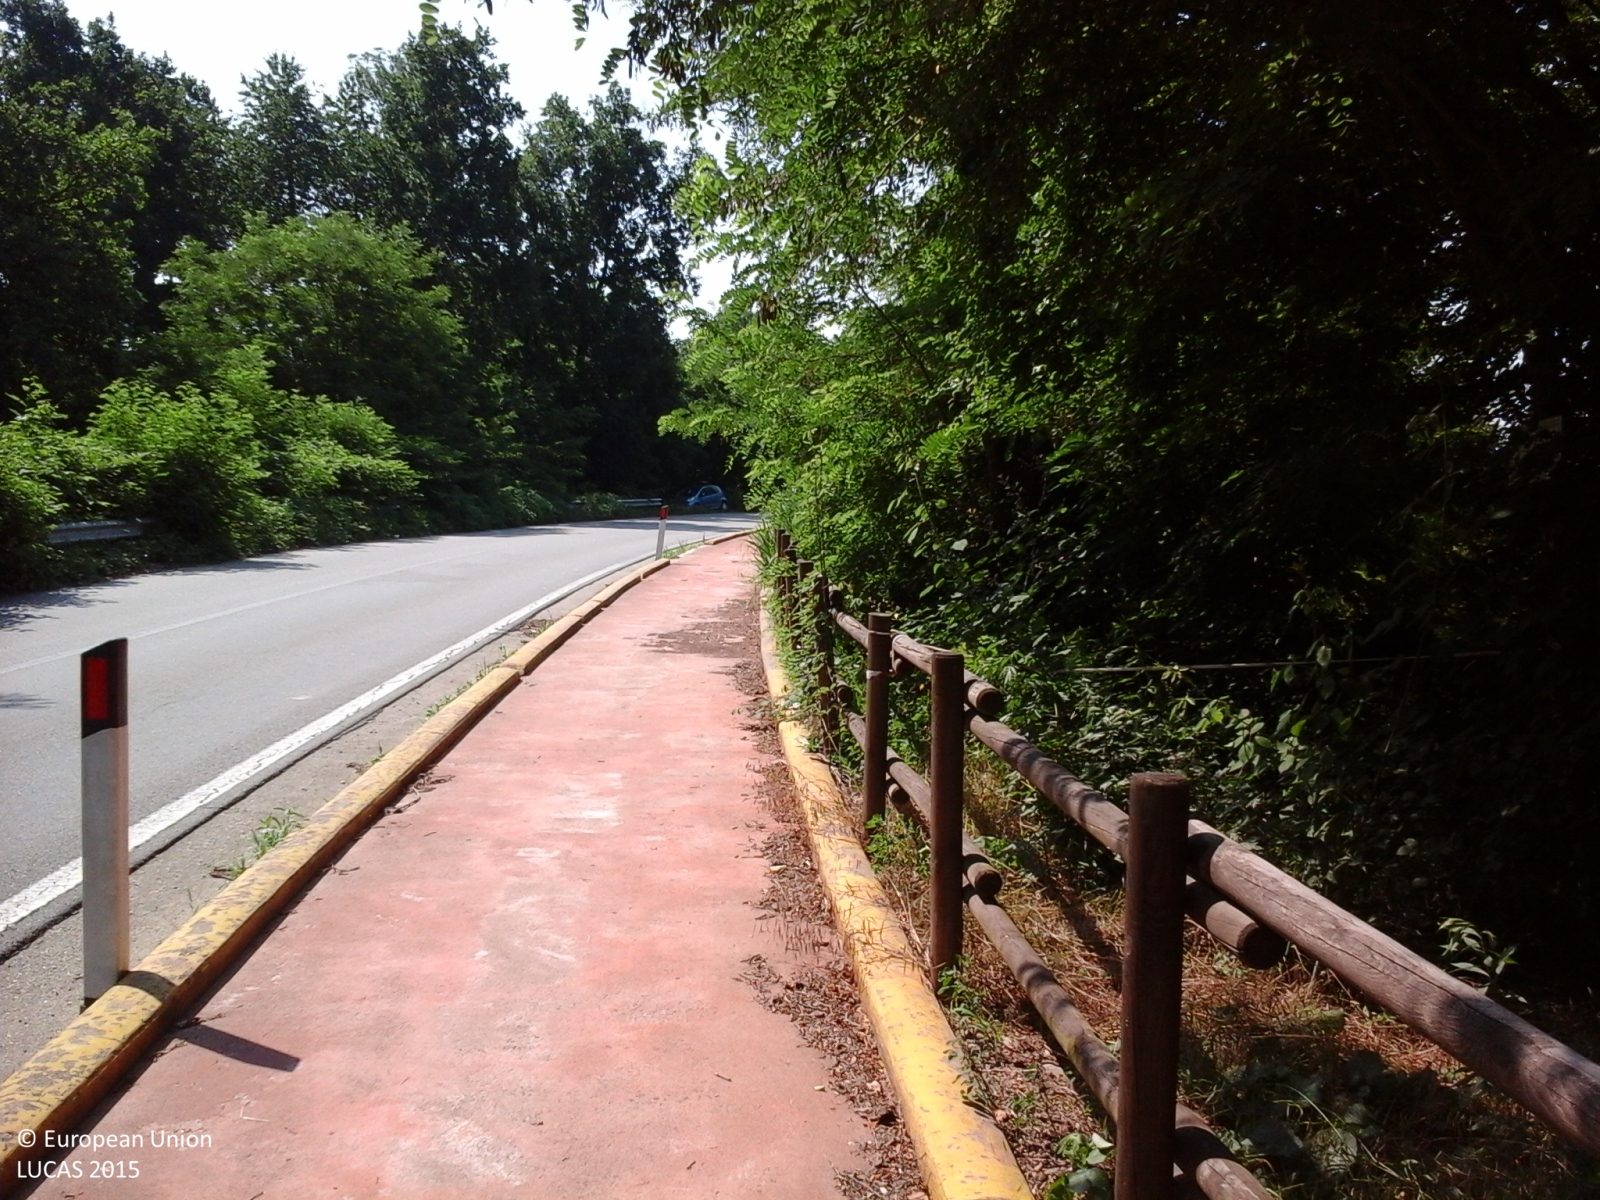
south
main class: Woodland
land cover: Broadleaved woodland
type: thermophilous deciduous forest
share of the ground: > 75 %
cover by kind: broadleaved forest trees 100 %
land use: Forestry
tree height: > 5 m
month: June
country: IT
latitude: 45.5255
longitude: 8.2232
